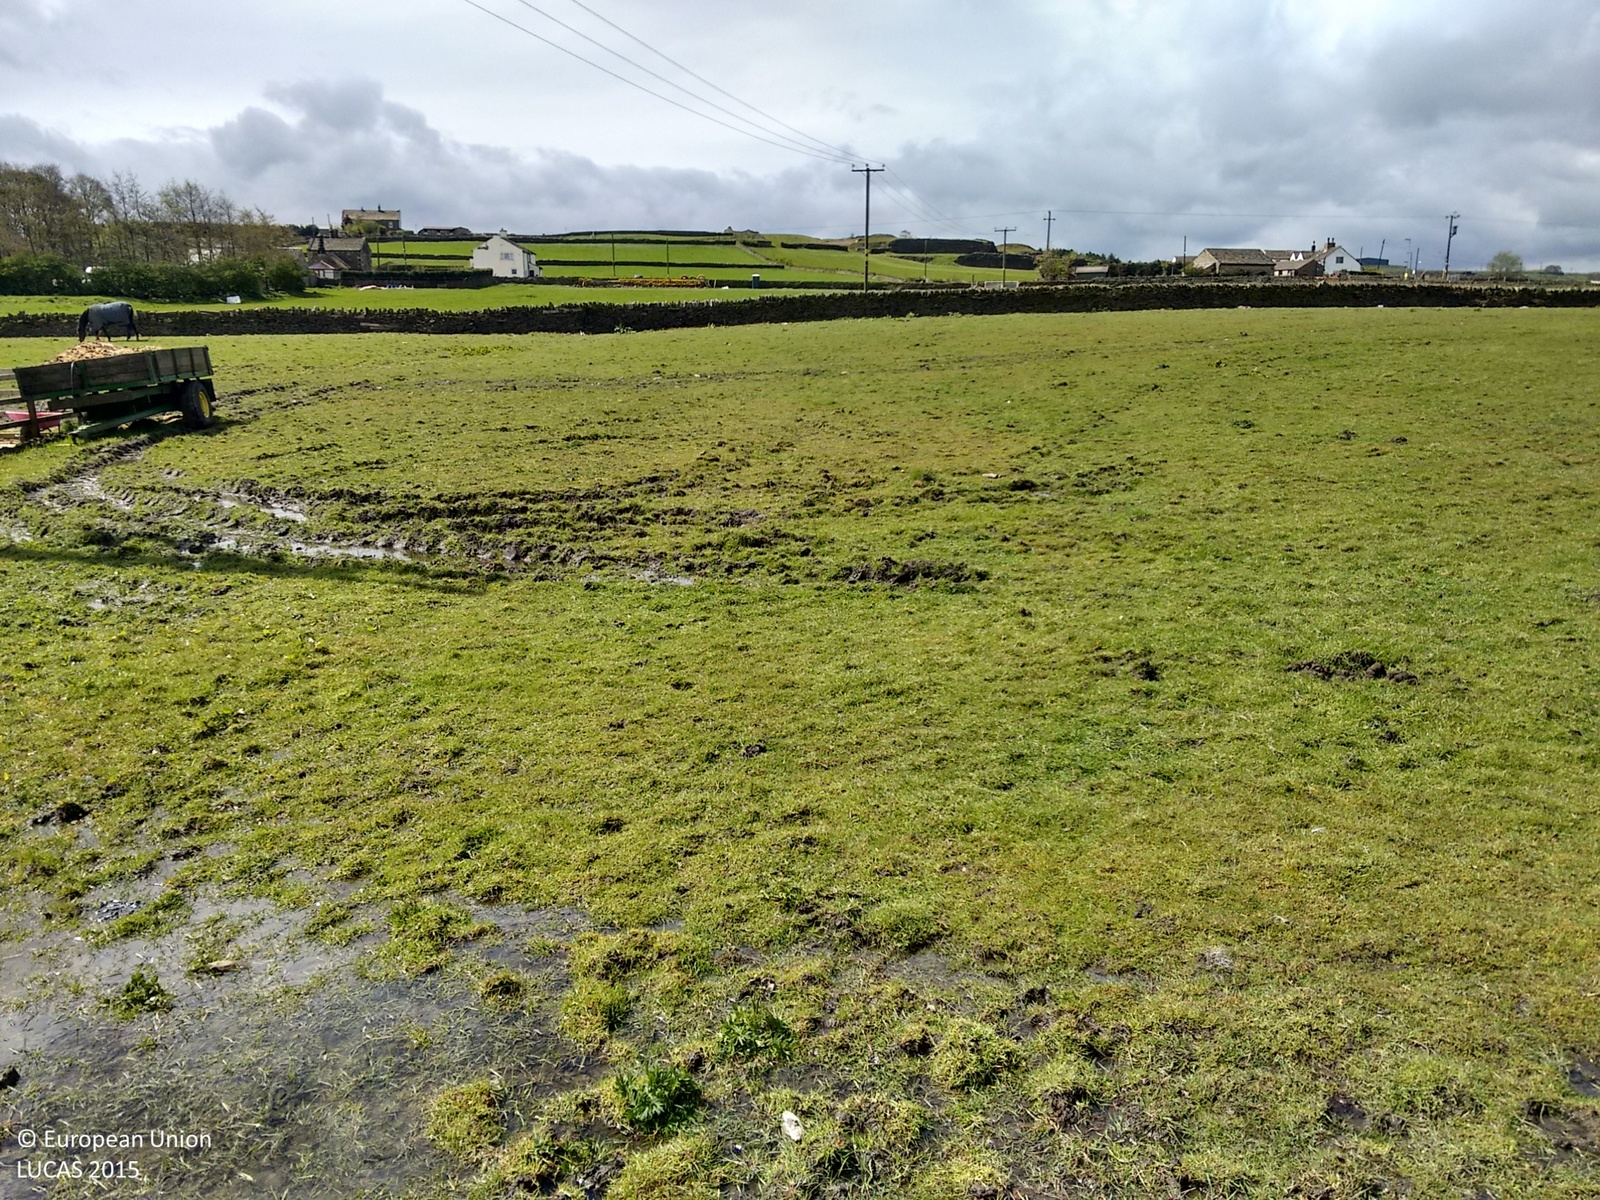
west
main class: Grassland
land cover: Grassland without tree/shrub cover
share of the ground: > 75 %
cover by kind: herbaceous plants 100 %
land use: Agriculture (excluding fallow land and kitchen gardens)
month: May
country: GB
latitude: 53.7462
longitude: -1.8367
